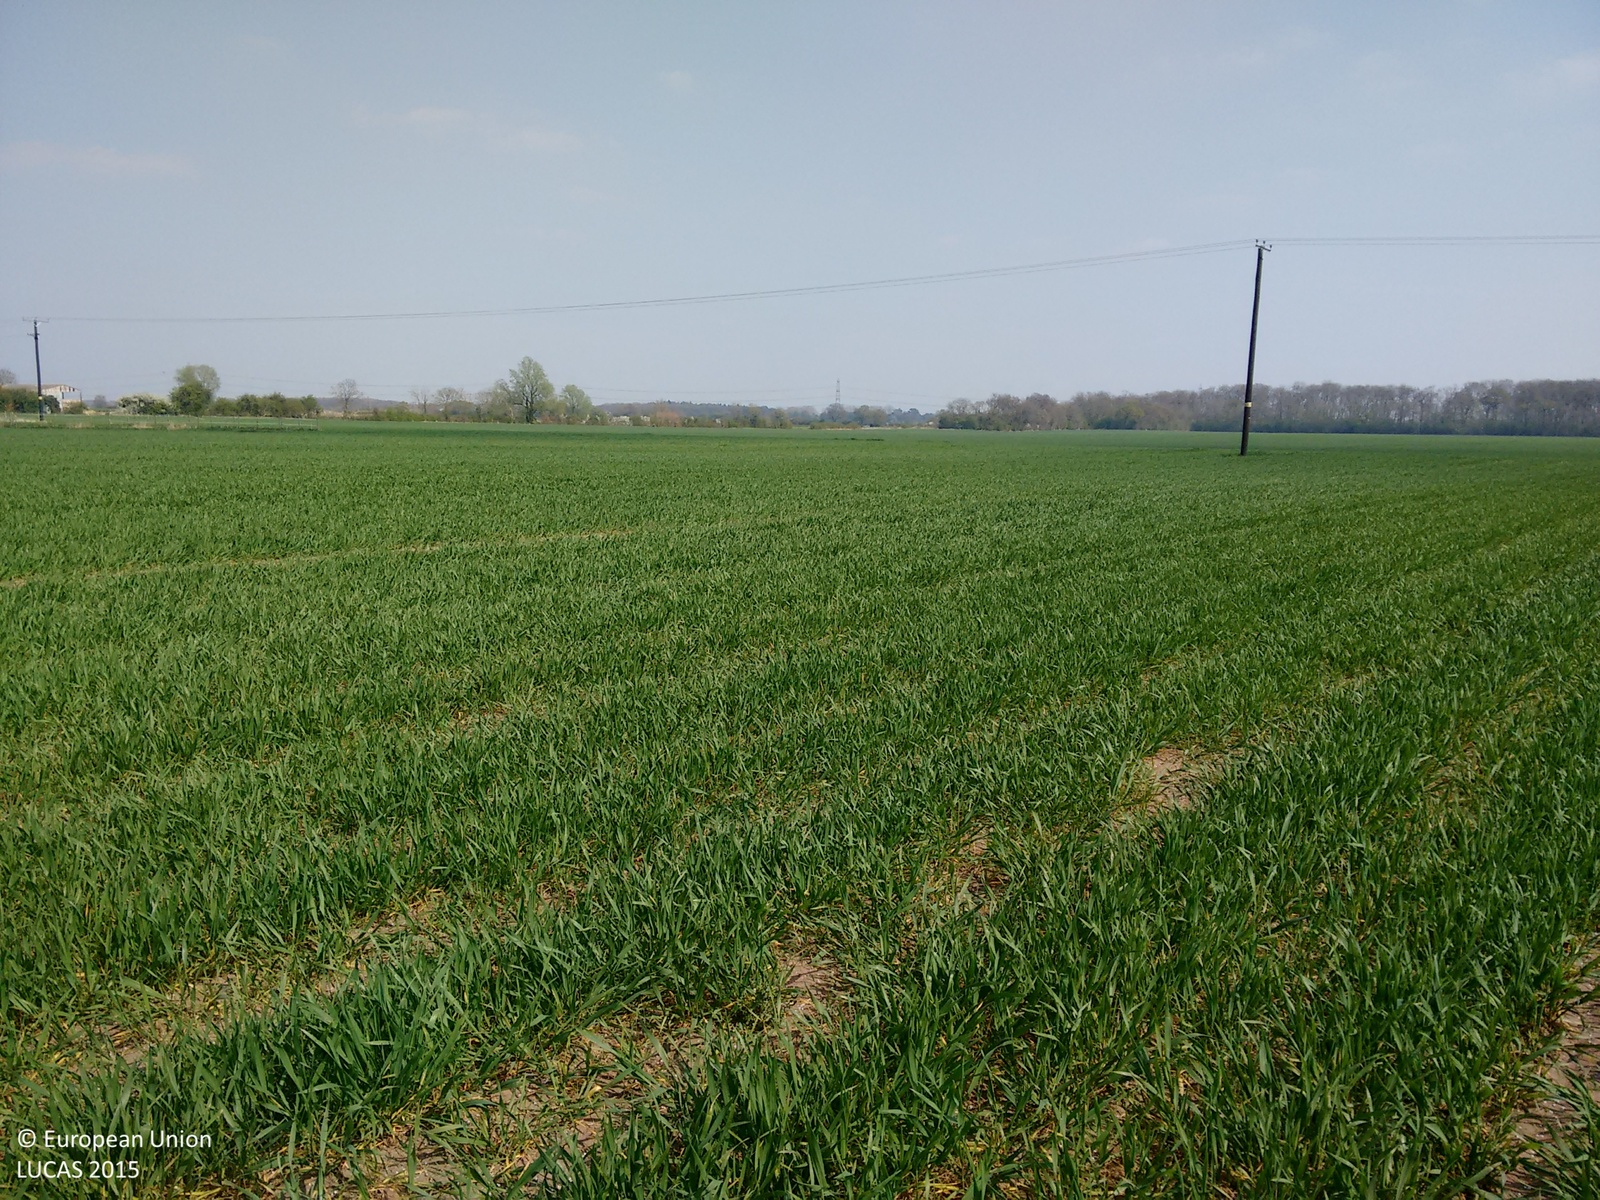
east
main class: Cropland
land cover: Common wheat
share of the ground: 50 - 75 %
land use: Agriculture (excluding fallow land and kitchen gardens)
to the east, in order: Common wheat; Electric lines; Common wheat
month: April
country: GB
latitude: 53.2178
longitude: -0.6878
